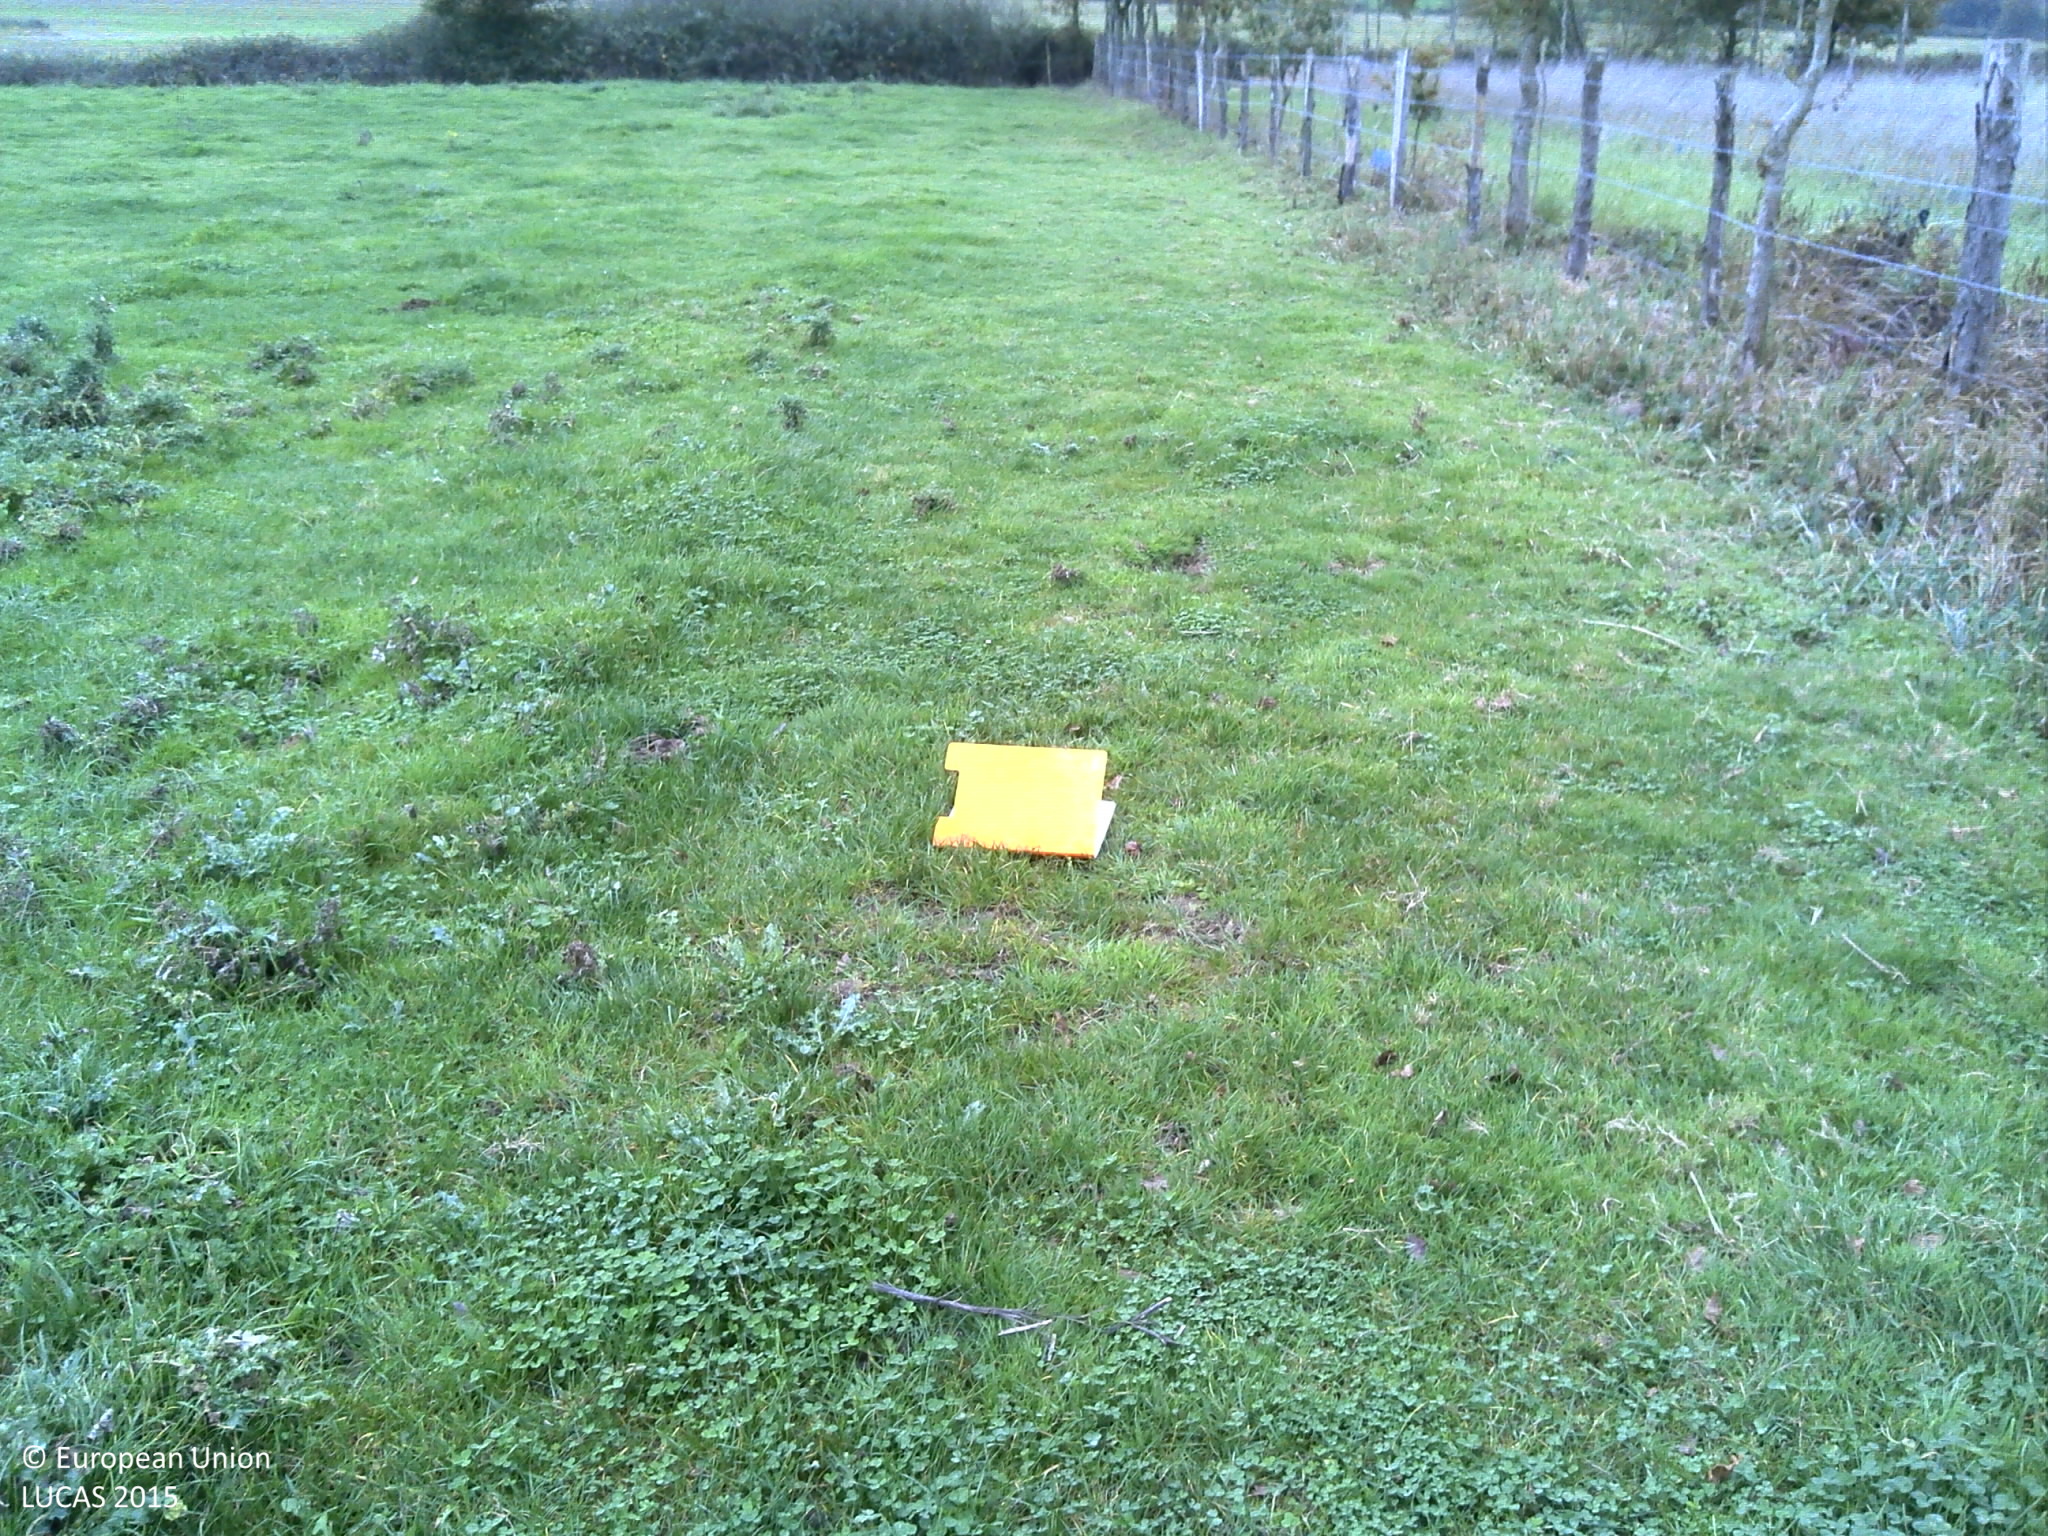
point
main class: Grassland
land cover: Grassland without tree/shrub cover
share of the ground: > 75 %
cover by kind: herbaceous plants 100 %
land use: Agriculture (excluding fallow land and kitchen gardens)
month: November
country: FR
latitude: 47.6362
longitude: -1.3412
